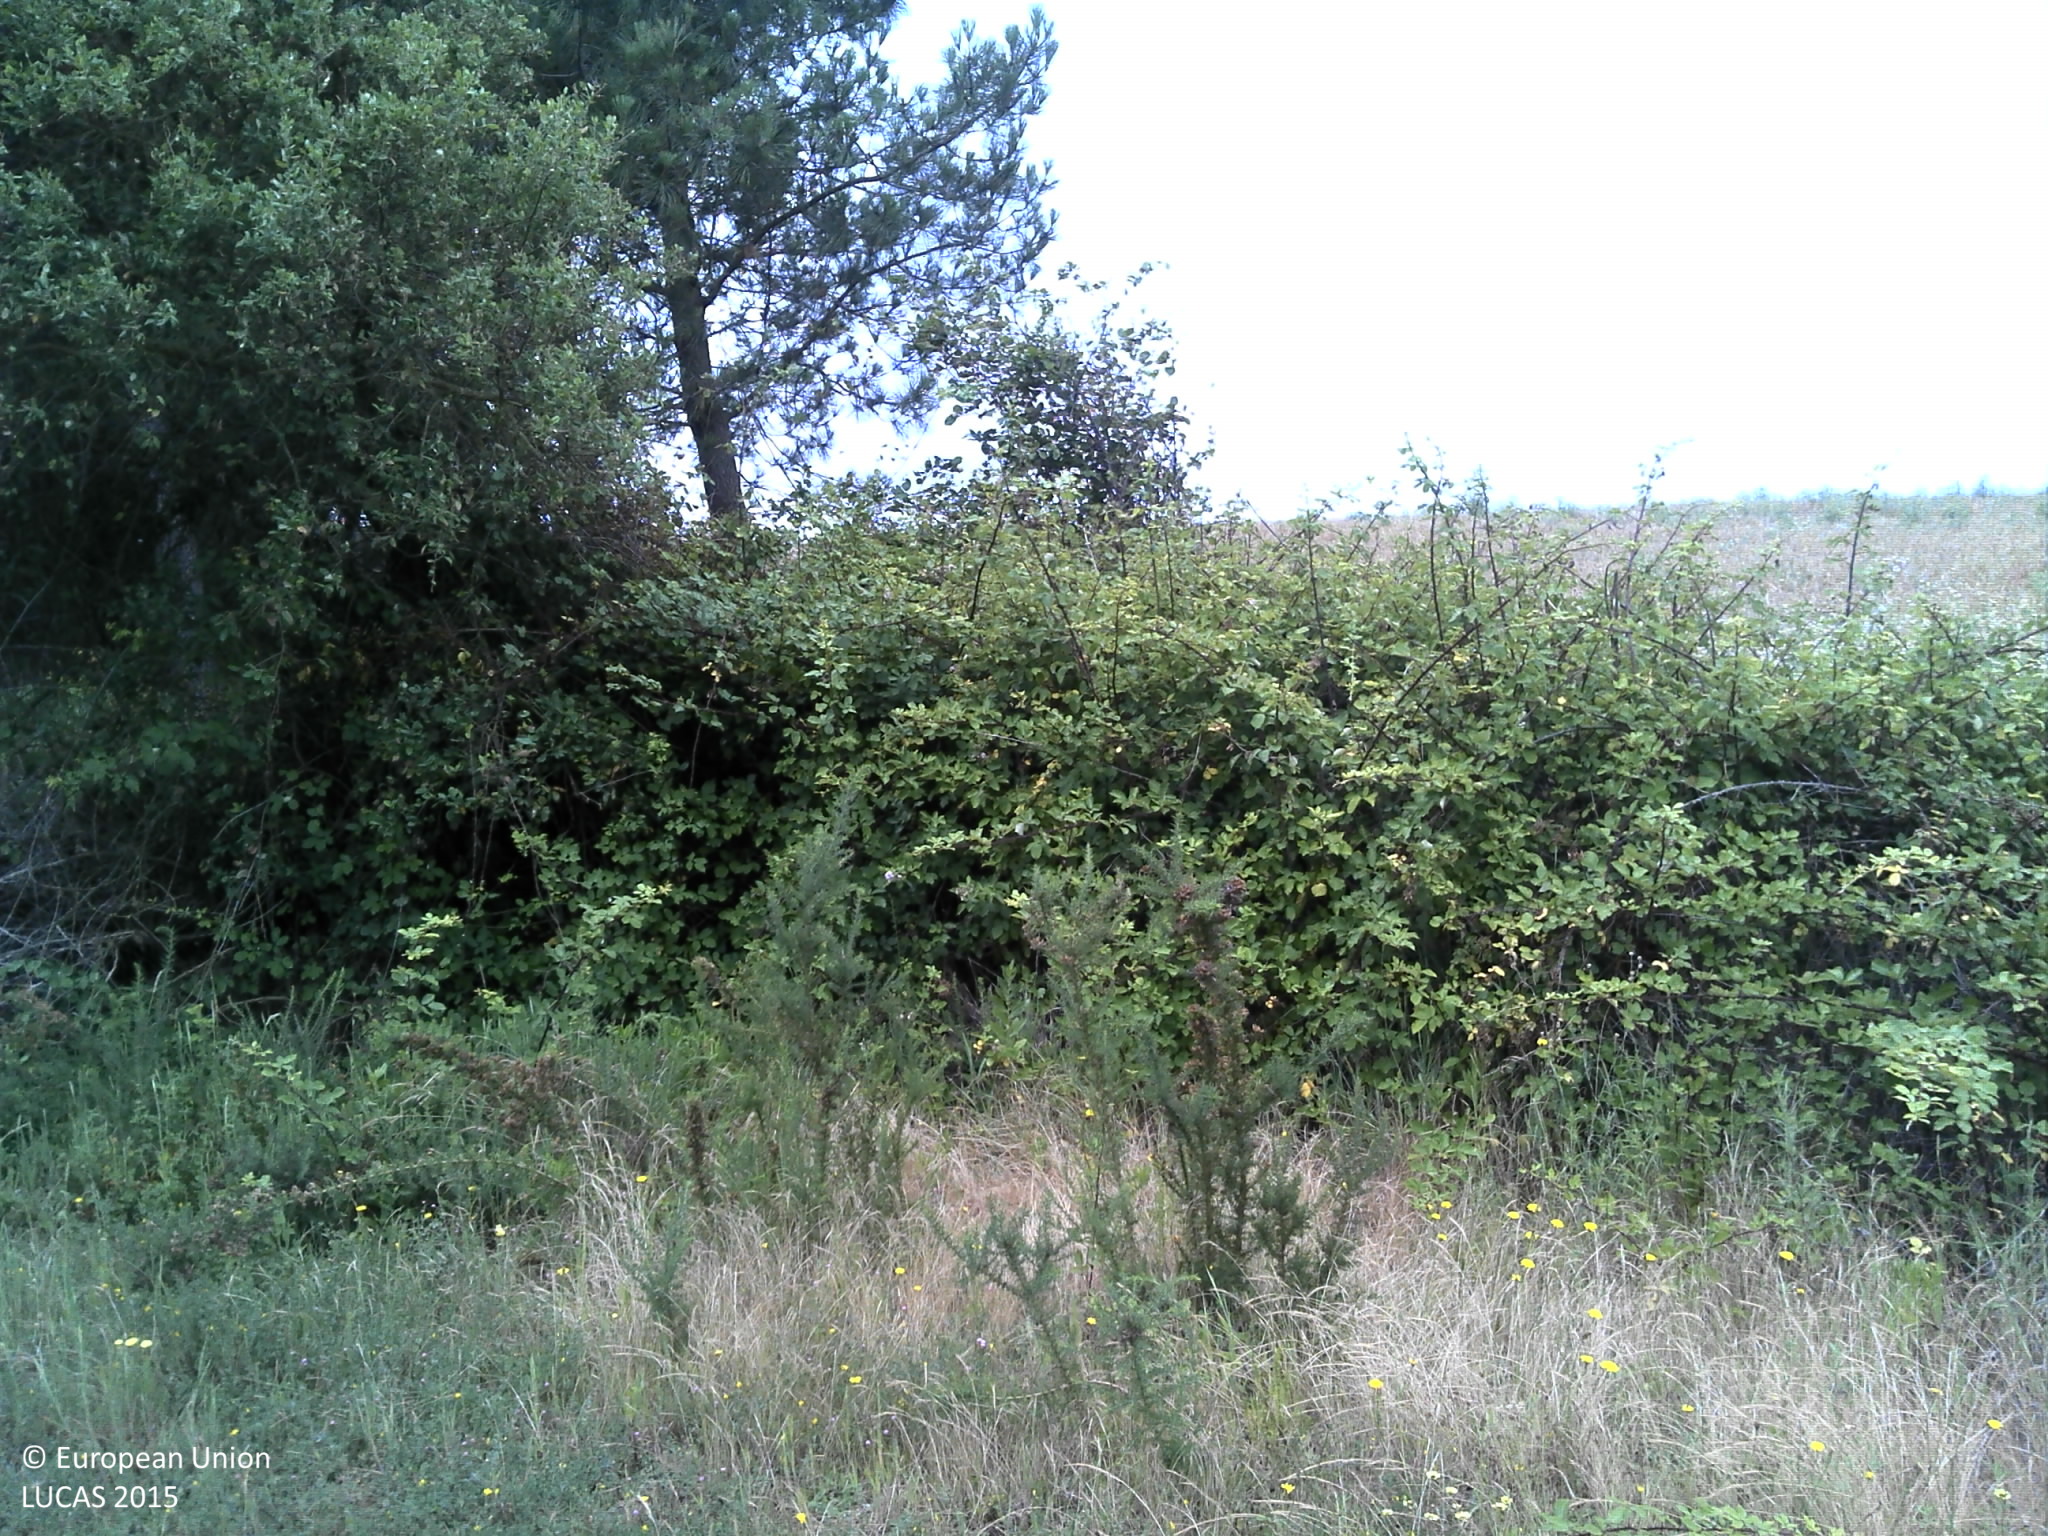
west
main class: Woodland
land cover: Pine dominated coniferous woodland
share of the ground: 10 - 25 %
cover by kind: herbaceous plants 60 %, shrubs 20 %, coniferous forest trees 10 %, unconsolidated bare surface 10 %
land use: Forestry
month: June
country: PT
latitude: 39.2418
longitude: -9.1930
